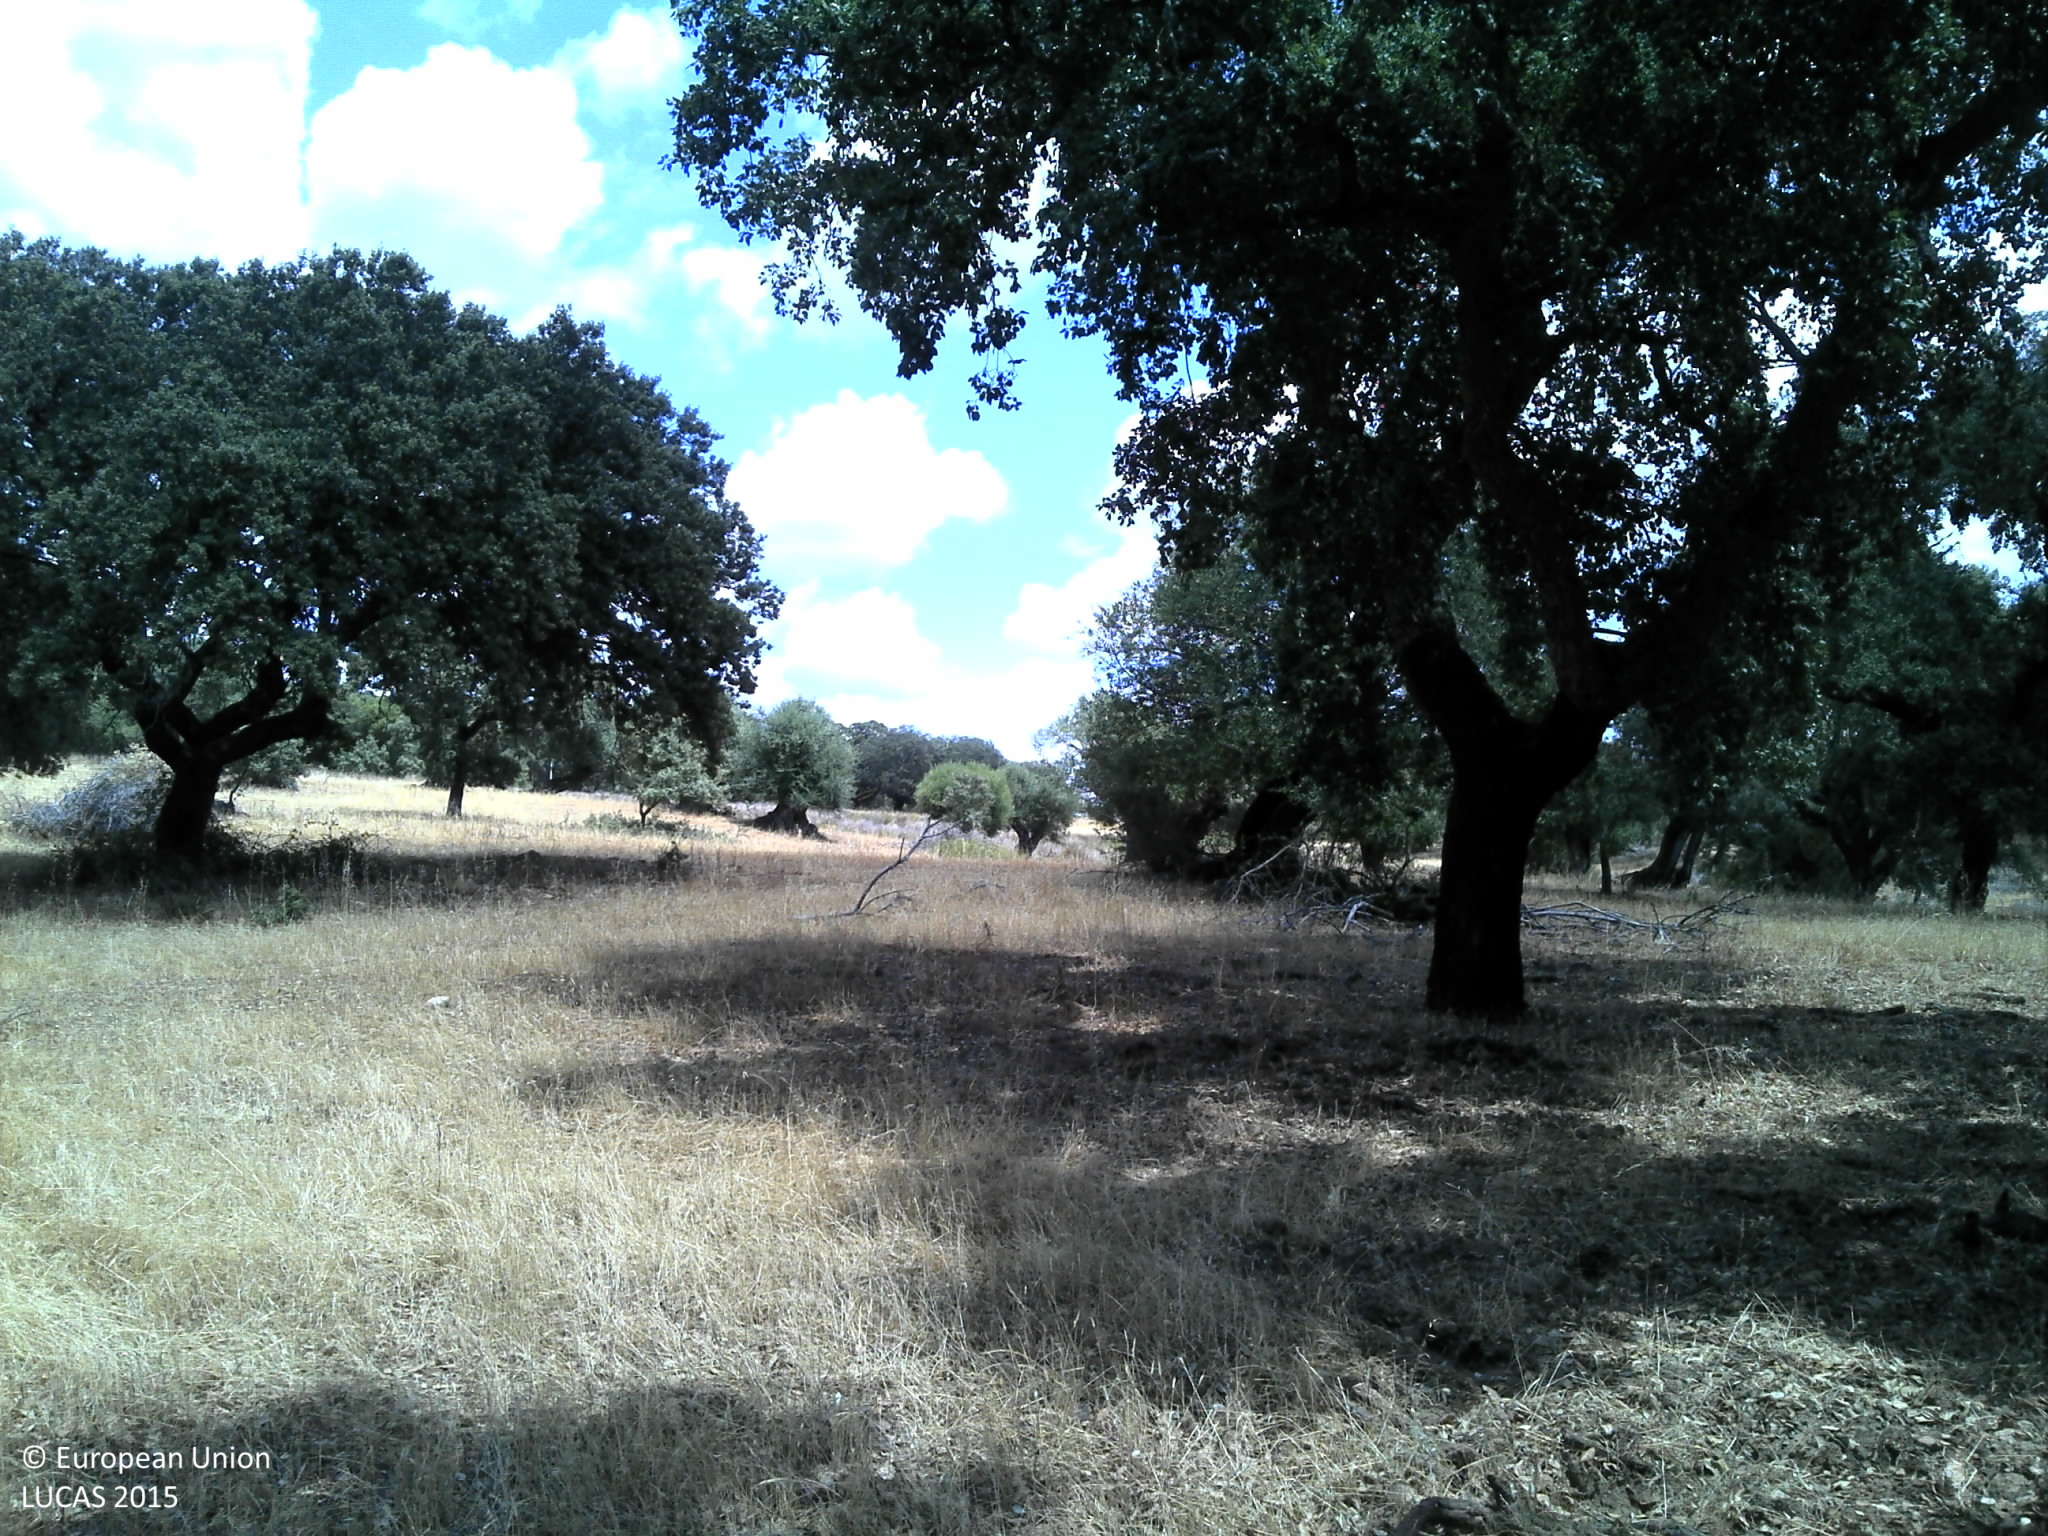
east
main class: Woodland
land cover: Broadleaved woodland
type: broadleaved evergreen forest
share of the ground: 50 - 75 %
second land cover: Grassland without tree/shrub cover
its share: 10 - 25 %
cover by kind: broadleaved forest trees 60 %, unconsolidated bare surface 25 %, herbaceous plants 15 %
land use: Forestry
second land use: Agriculture (excluding fallow land and kitchen gardens)
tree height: > 5 m
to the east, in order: Broadleaved woodland; Grassland without tree/shrub cover; Broadleaved woodland; Grassland without tree/shrub cover; Broadleaved woodland
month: June
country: PT
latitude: 38.5246
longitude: -8.1328
